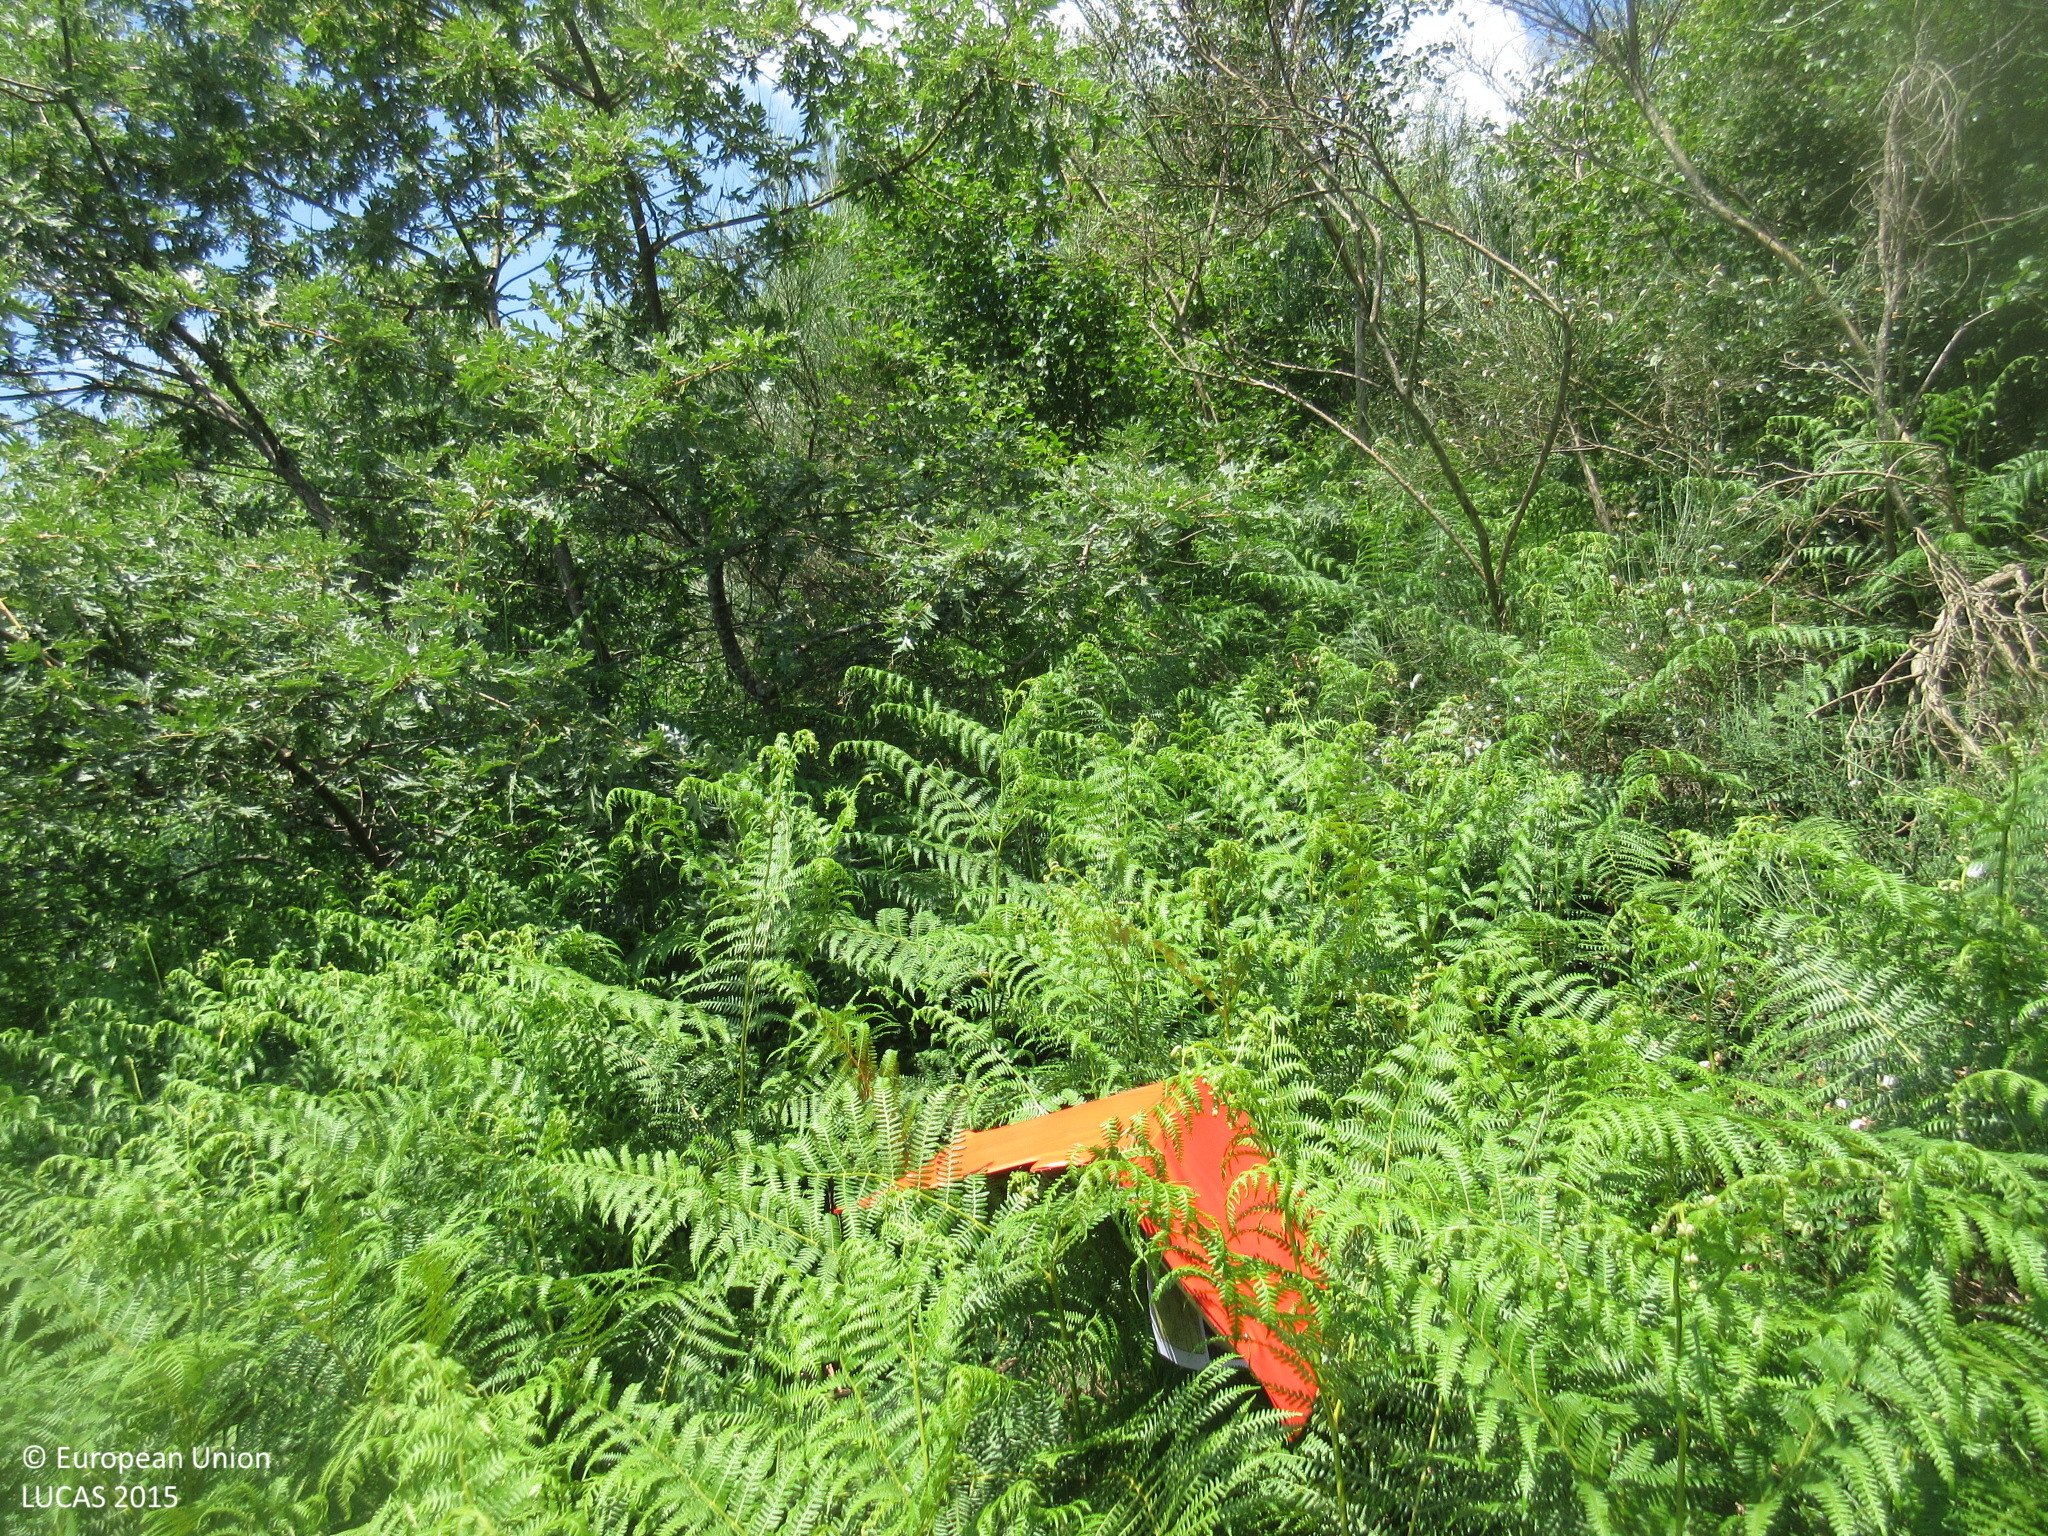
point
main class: Woodland
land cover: Other mixed woodland
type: acidophilous oak and oak-birch forest
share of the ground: > 75 %
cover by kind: broadleaved forest trees 60 %, coniferous forest trees 30 %, shrubs 10 %
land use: Forestry
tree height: > 5 m
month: June
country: ES
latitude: 43.0174
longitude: -7.0580
